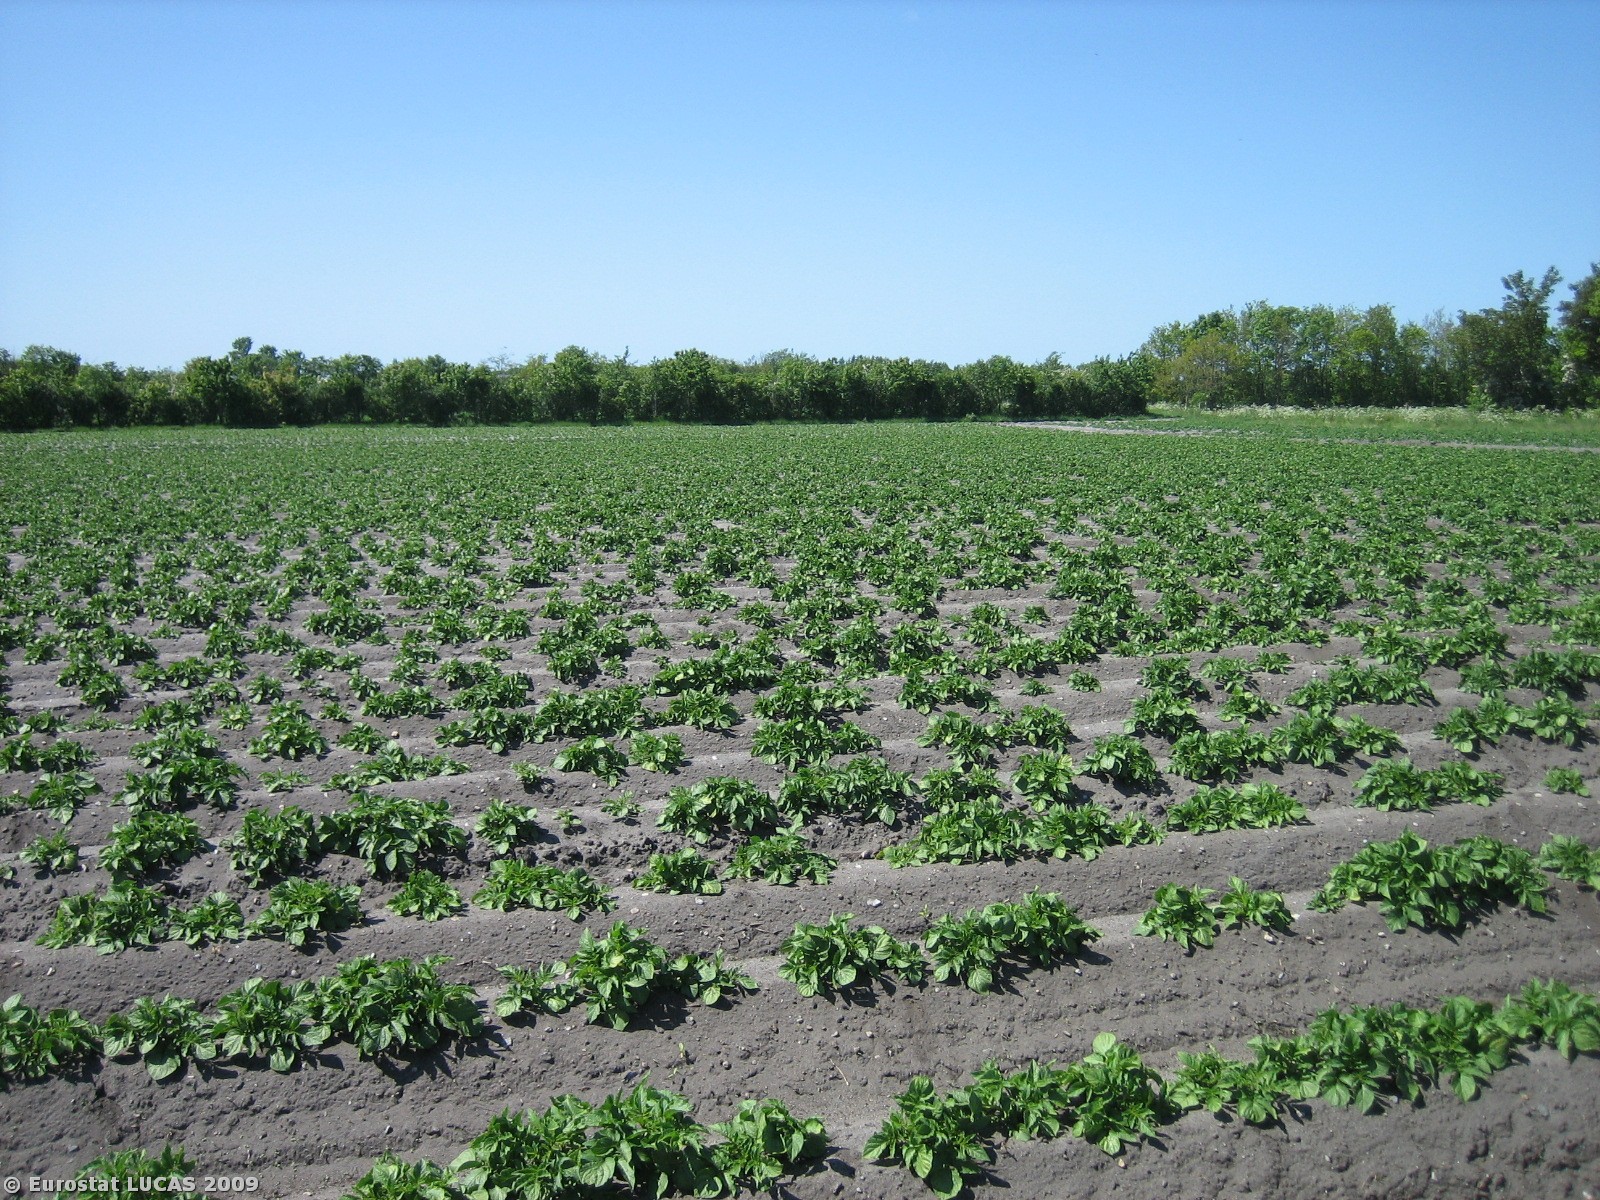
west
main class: Cropland
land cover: Potatoes
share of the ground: 10 - 25 %
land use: Agriculture (excluding fallow land and kitchen gardens)
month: May
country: DK
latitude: 55.9128
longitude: 8.8333
